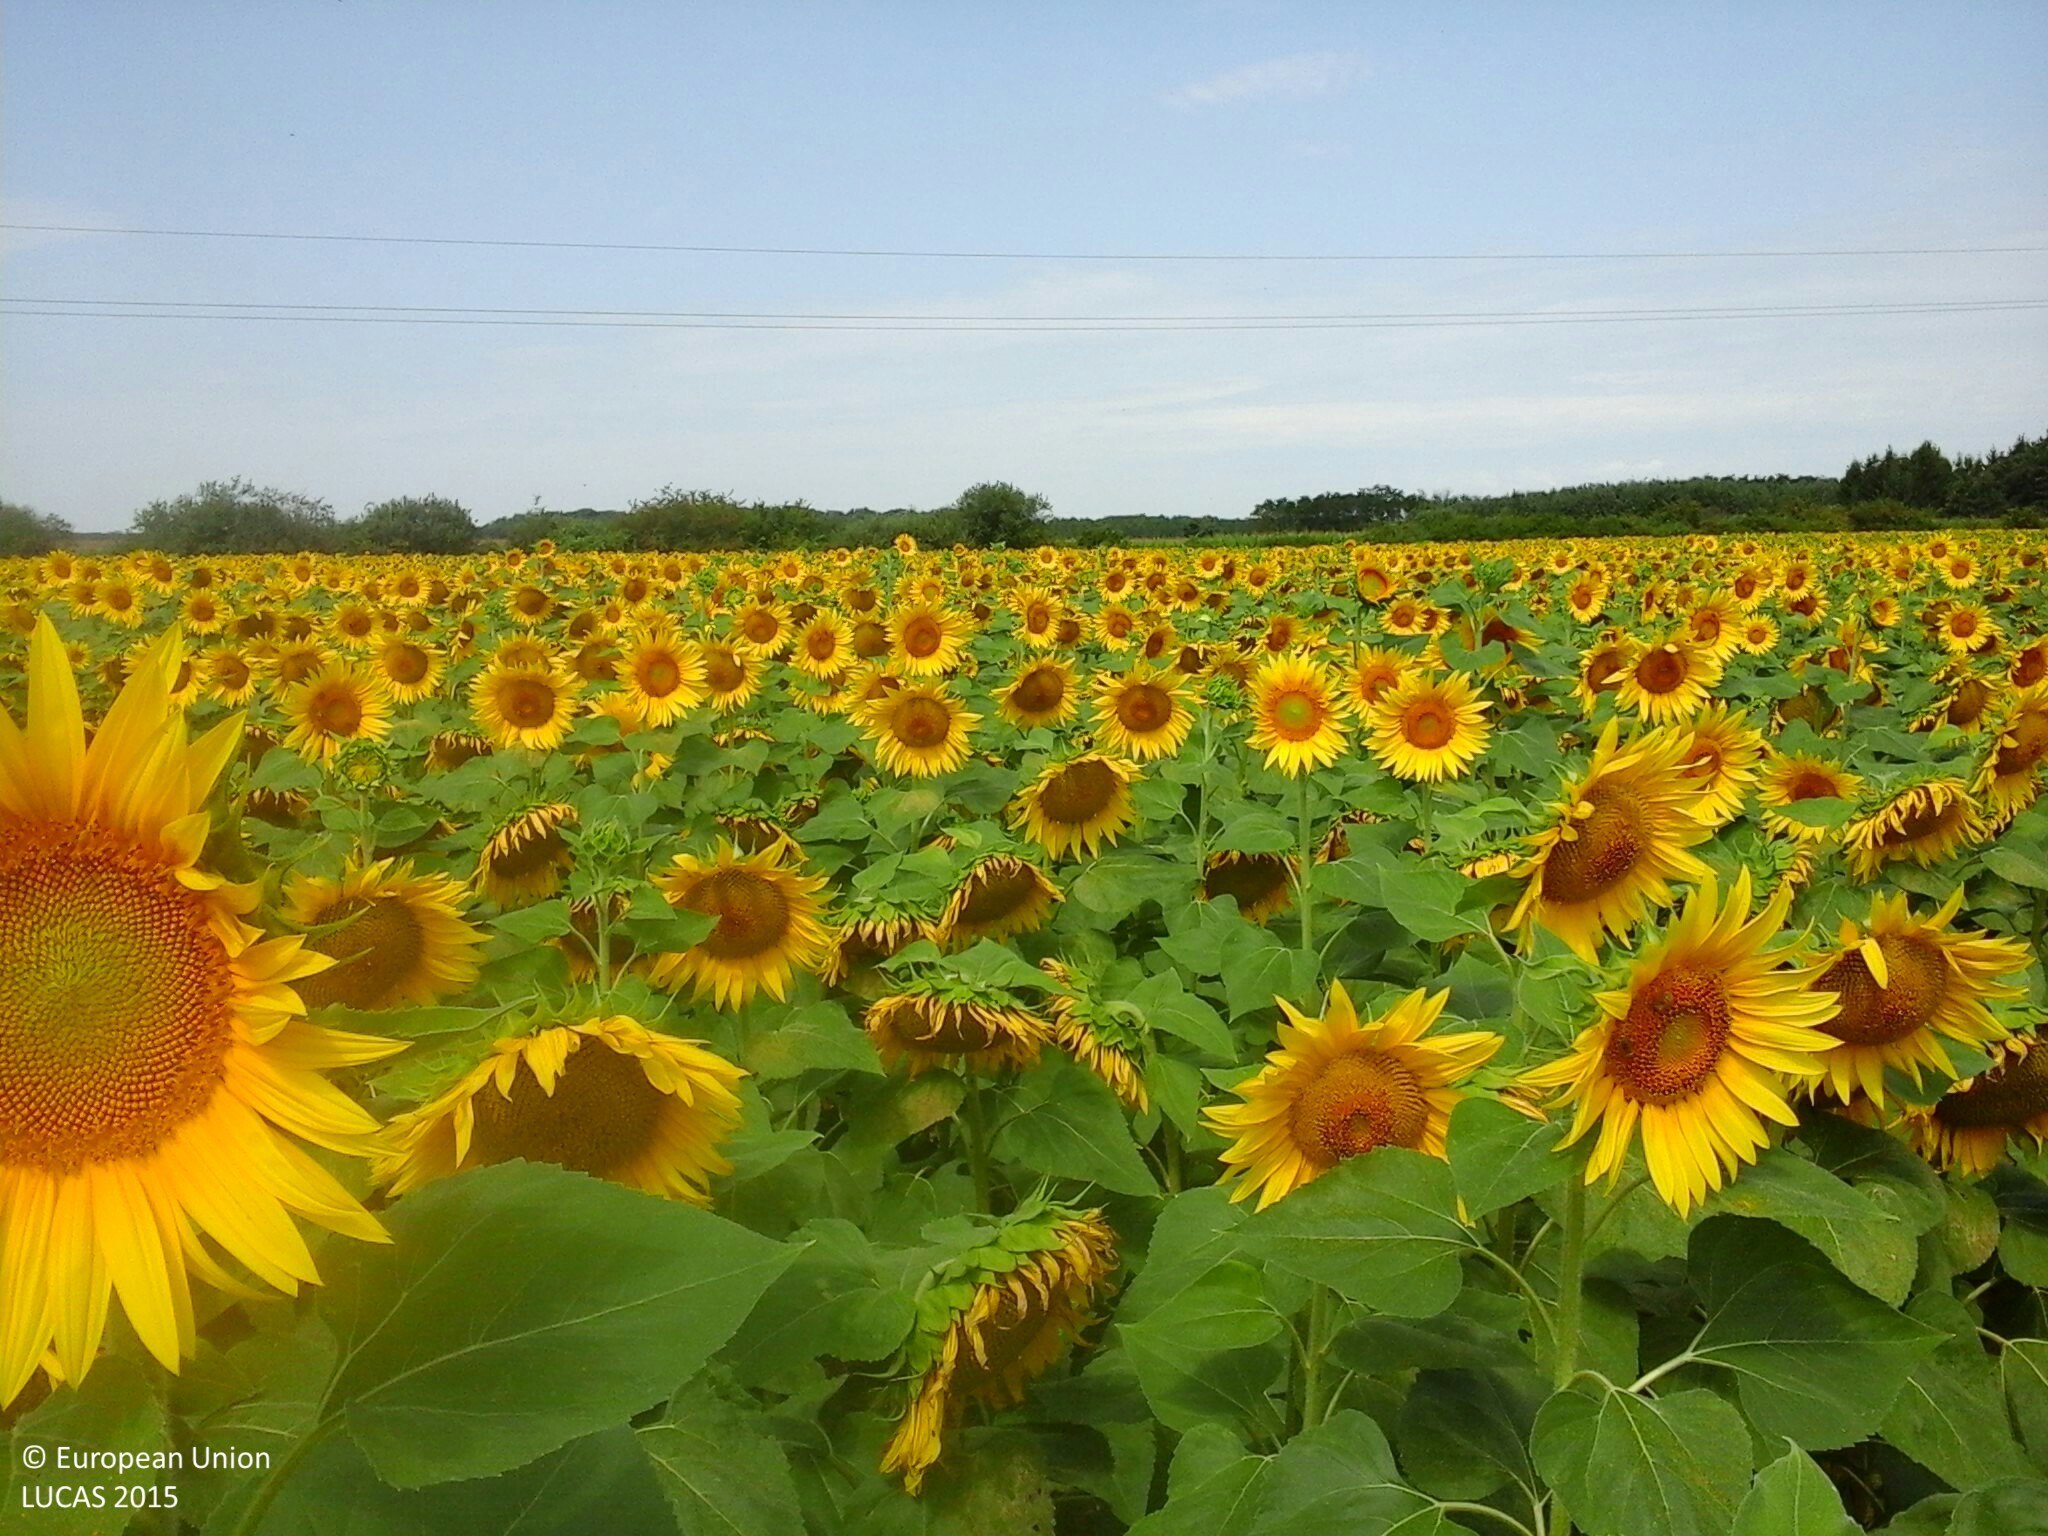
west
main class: Cropland
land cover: Sunflower
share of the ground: > 75 %
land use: Agriculture (excluding fallow land and kitchen gardens)
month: July
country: HU
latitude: 47.0344
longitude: 16.5695
